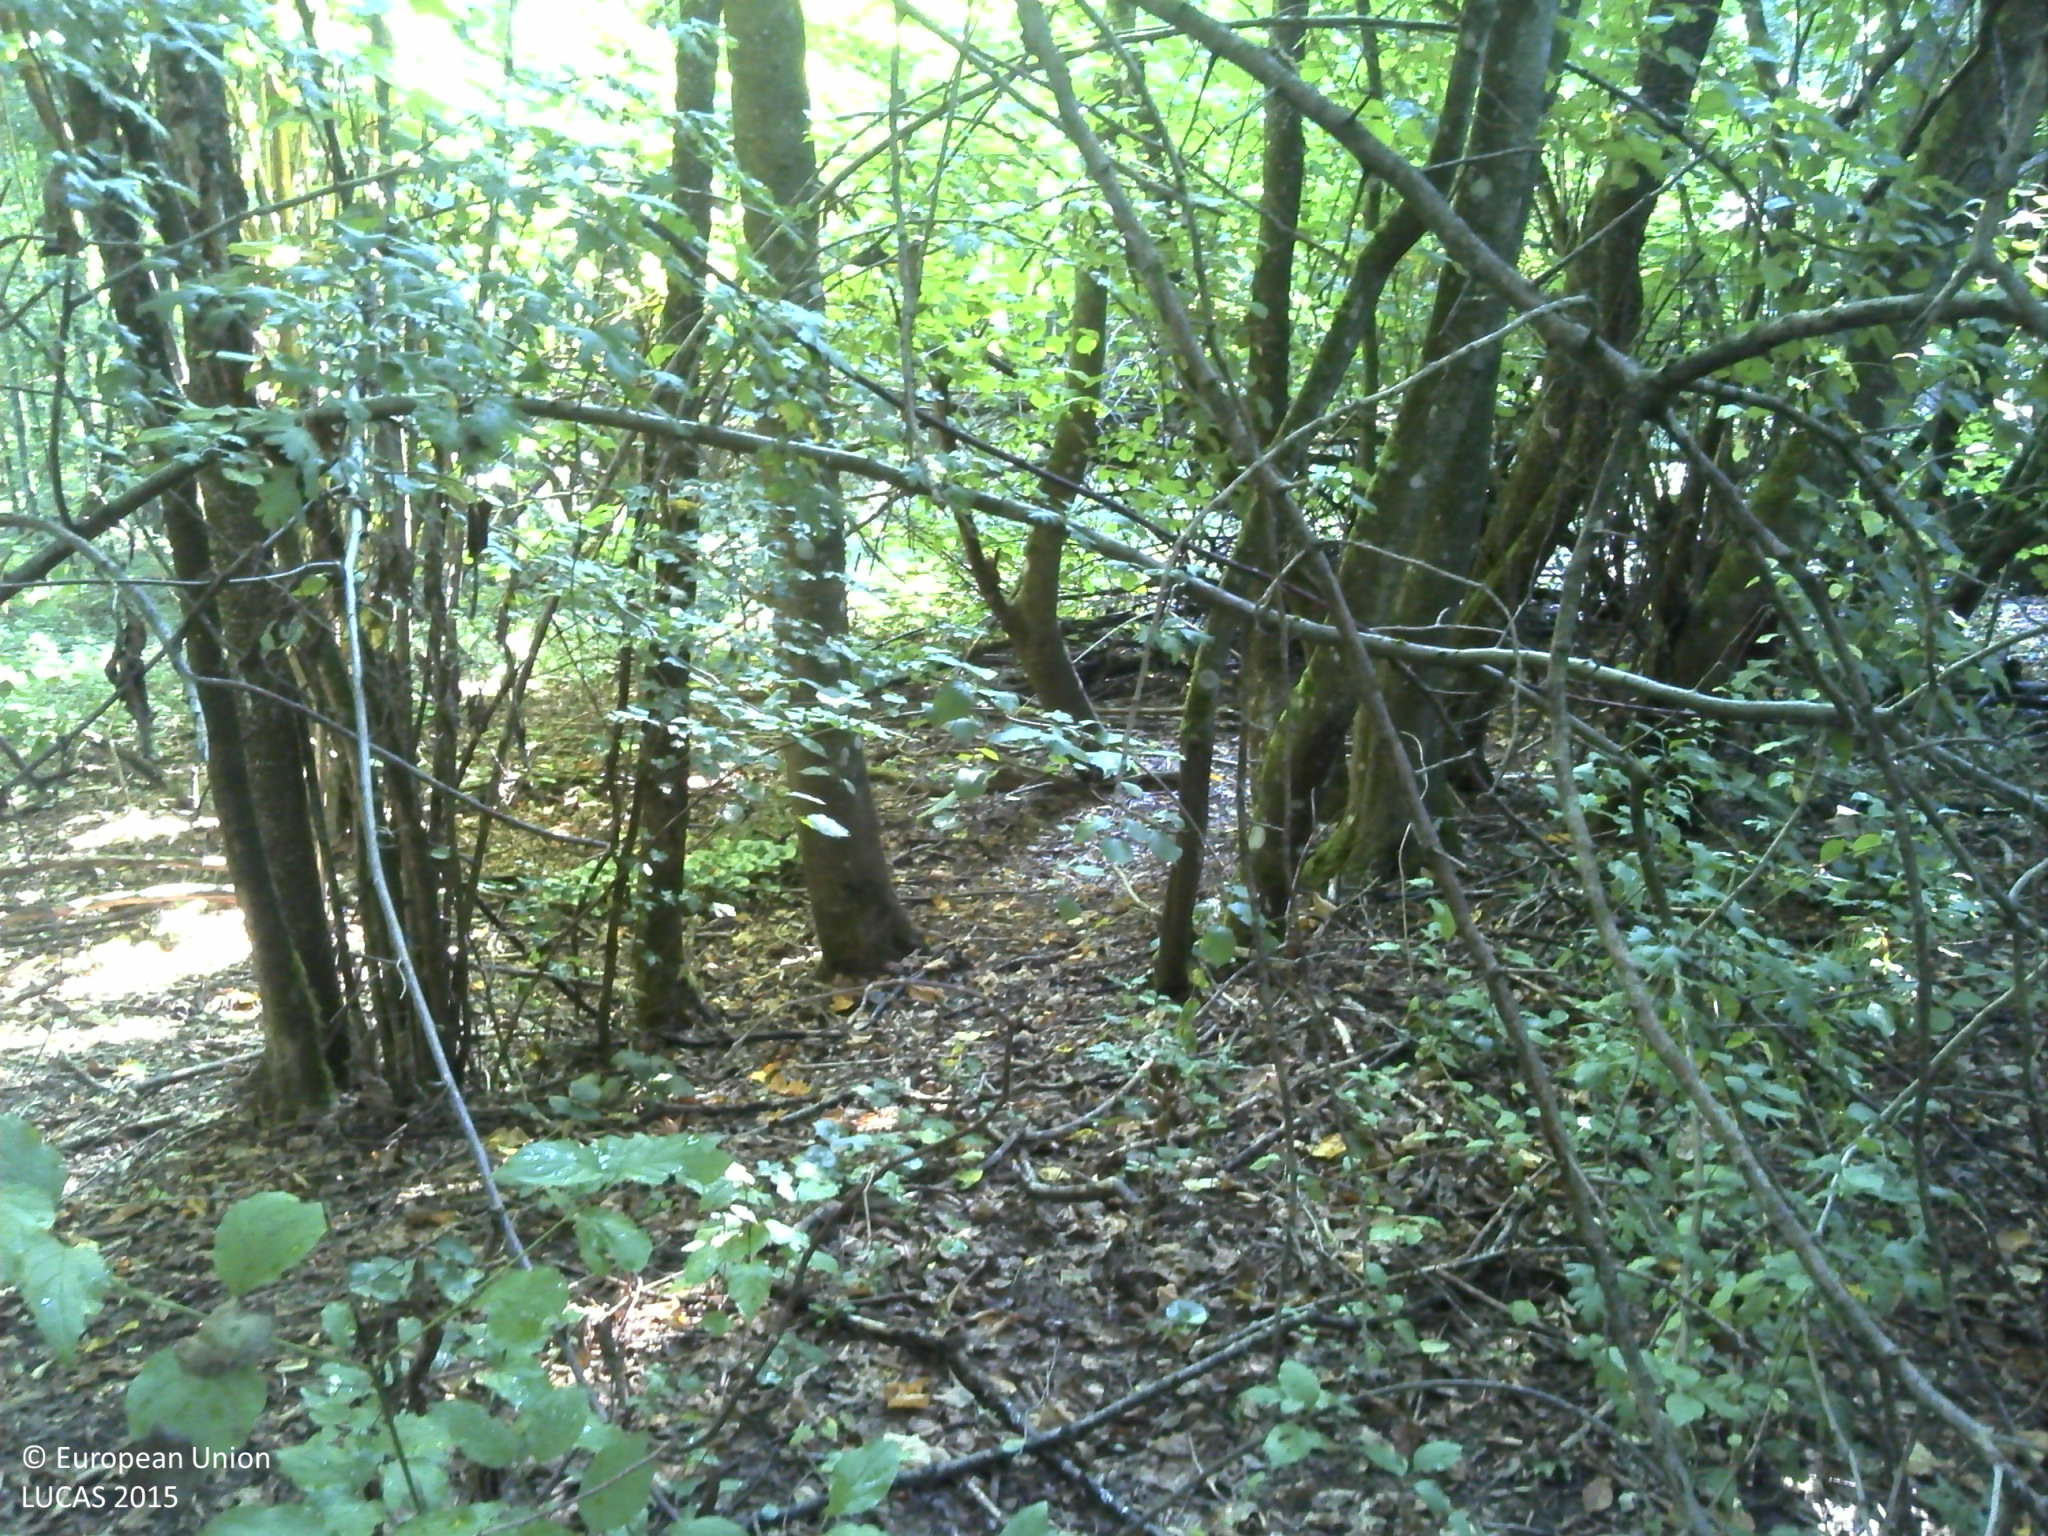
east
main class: Woodland
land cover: Broadleaved woodland
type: beech forest
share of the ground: > 75 %
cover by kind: broadleaved forest trees 100 %
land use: Forestry
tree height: > 5 m
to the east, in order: Broadleaved woodland; Spontaneously vegetated surfaces; Shrubland with sparse tree cover; Spontaneously vegetated surfaces
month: August
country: HR
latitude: 45.0971
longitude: 16.3375
